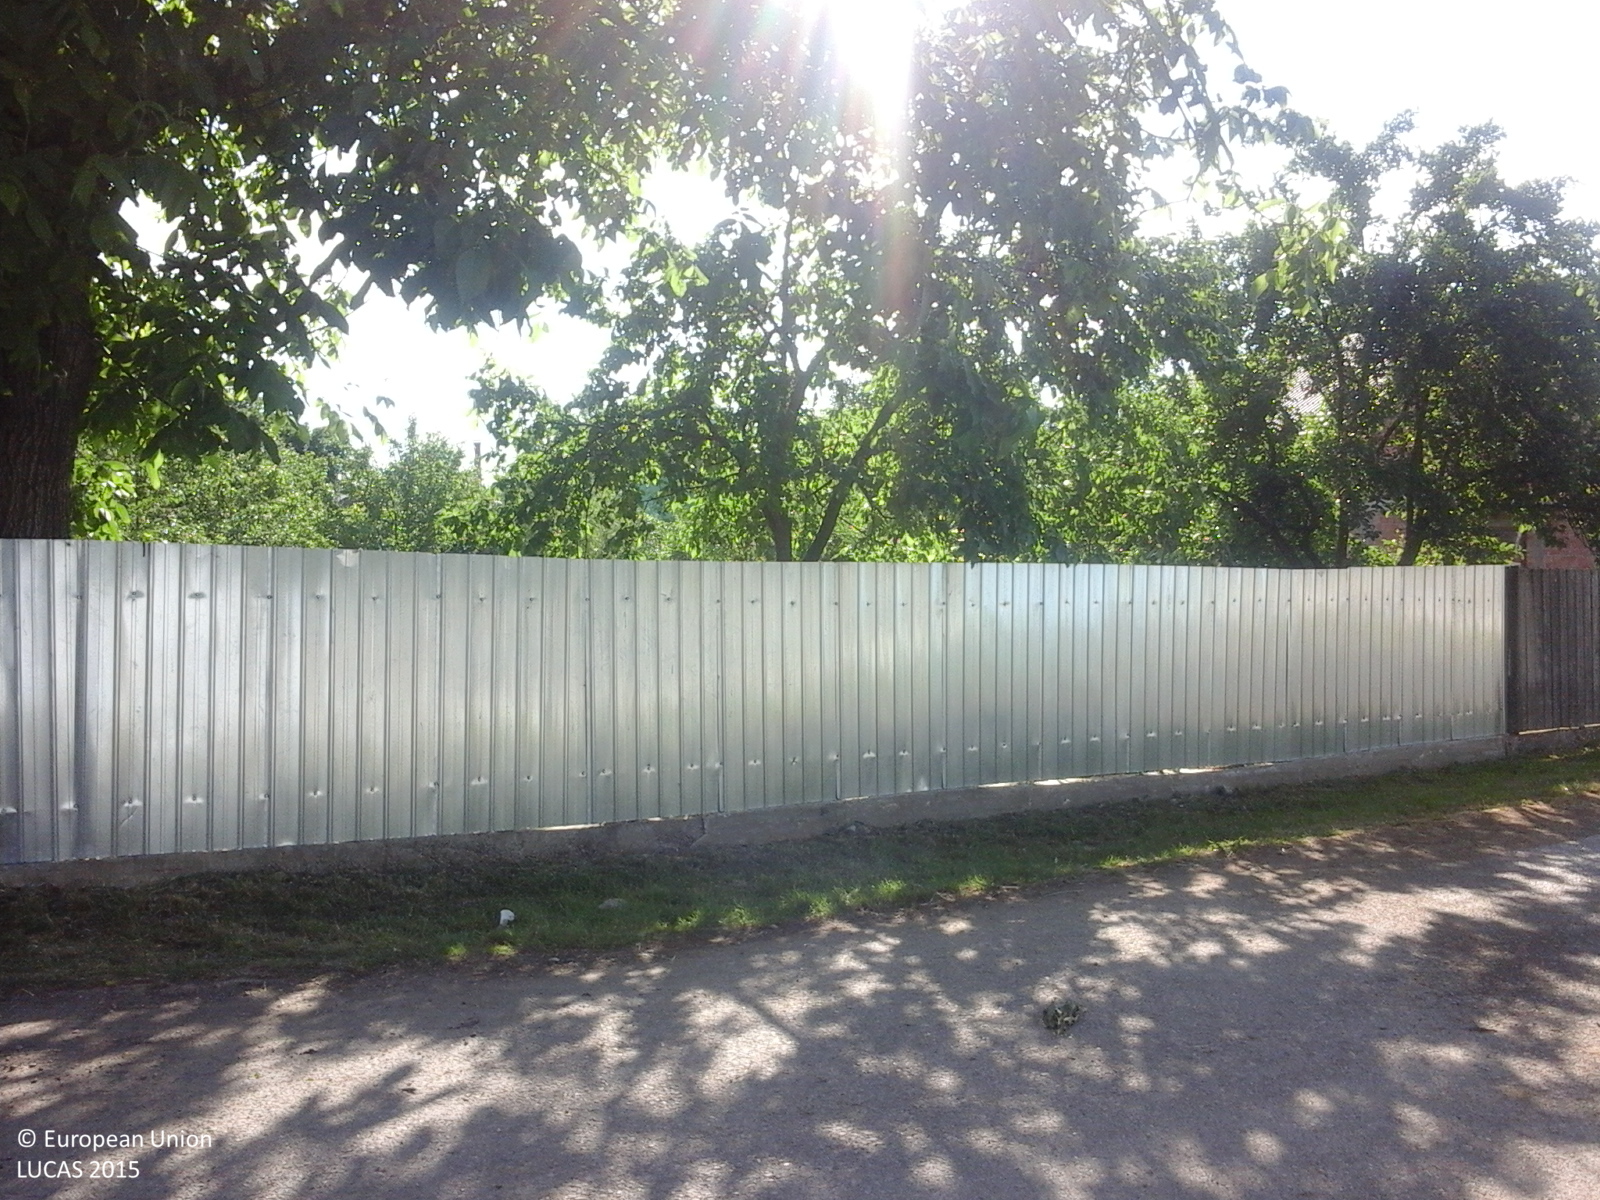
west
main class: Grassland
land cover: Grassland without tree/shrub cover
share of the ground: 50 - 75 %
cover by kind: herbaceous plants 100 %
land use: Agriculture (excluding fallow land and kitchen gardens)
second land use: Residential
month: June
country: RO
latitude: 46.6634
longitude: 26.8074
